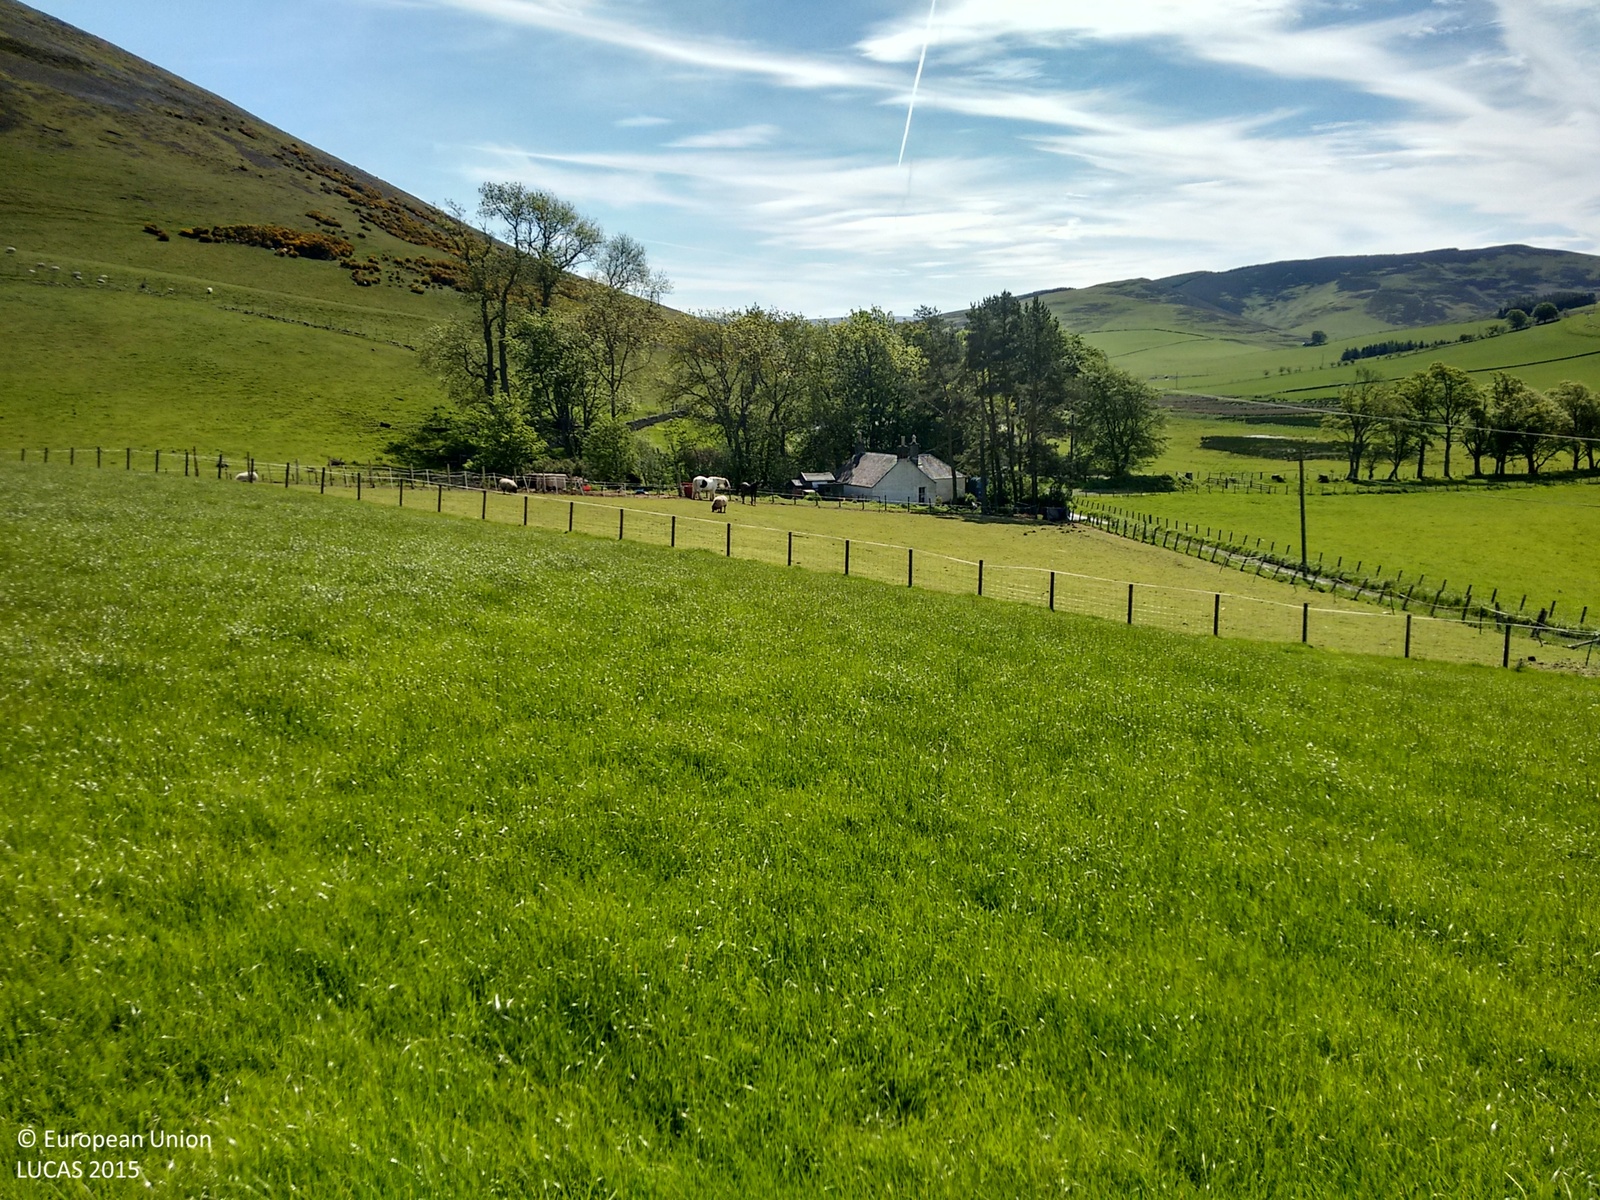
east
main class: Grassland
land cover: Grassland without tree/shrub cover
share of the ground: > 75 %
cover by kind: herbaceous plants 100 %
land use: Agriculture (excluding fallow land and kitchen gardens)
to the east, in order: Grassland without tree/shrub cover; Fences; Grassland without tree/shrub cover; Managed hedges; Grass margins; Rivers and streams; Grass margins; Managed hedges; Fences; Grassland without tree/shrub cover; Fences; Grassland without tree/shrub cover
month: June
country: GB
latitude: 55.5989
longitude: -3.4891
